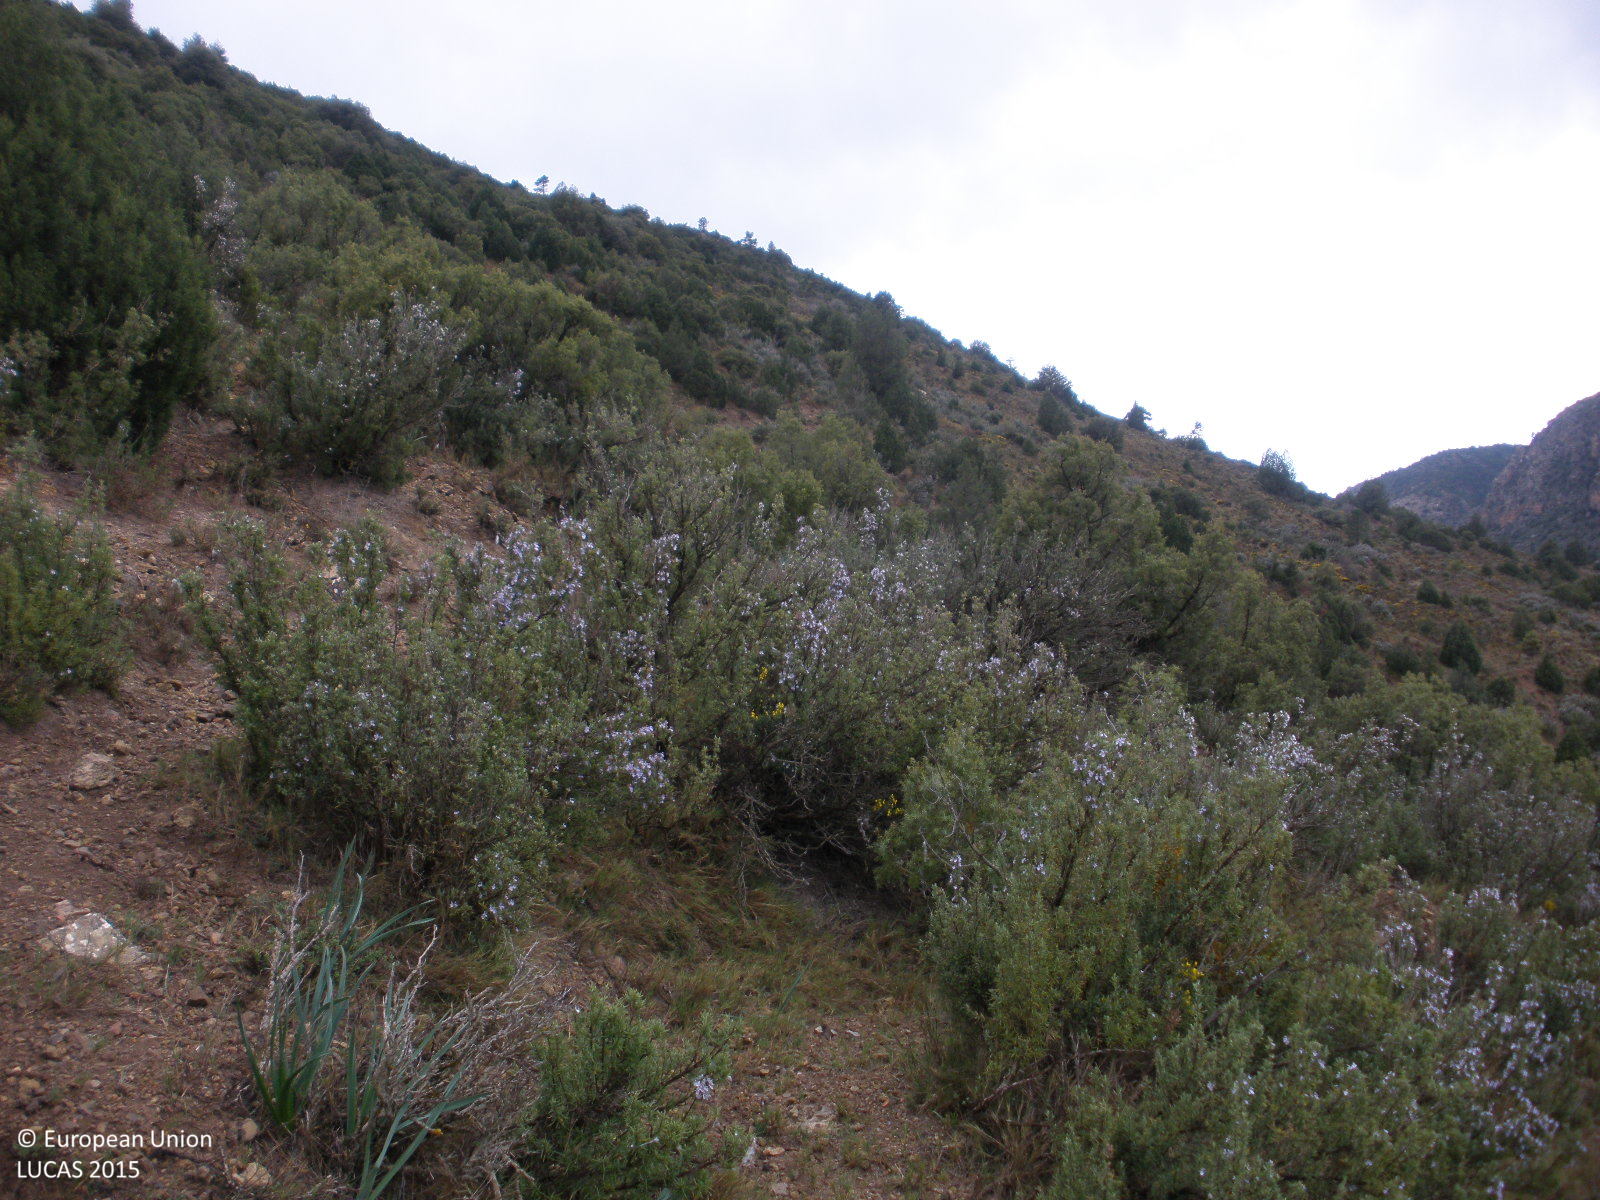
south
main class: Shrubland
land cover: Shrubland without tree cover
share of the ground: 50 - 75 %
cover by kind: shrubs 60 %, consolidated bare surface 30 %, herbaceous plants 10 %
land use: Agriculture (excluding fallow land and kitchen gardens)
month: April
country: ES
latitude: 40.2429
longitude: -1.2128
